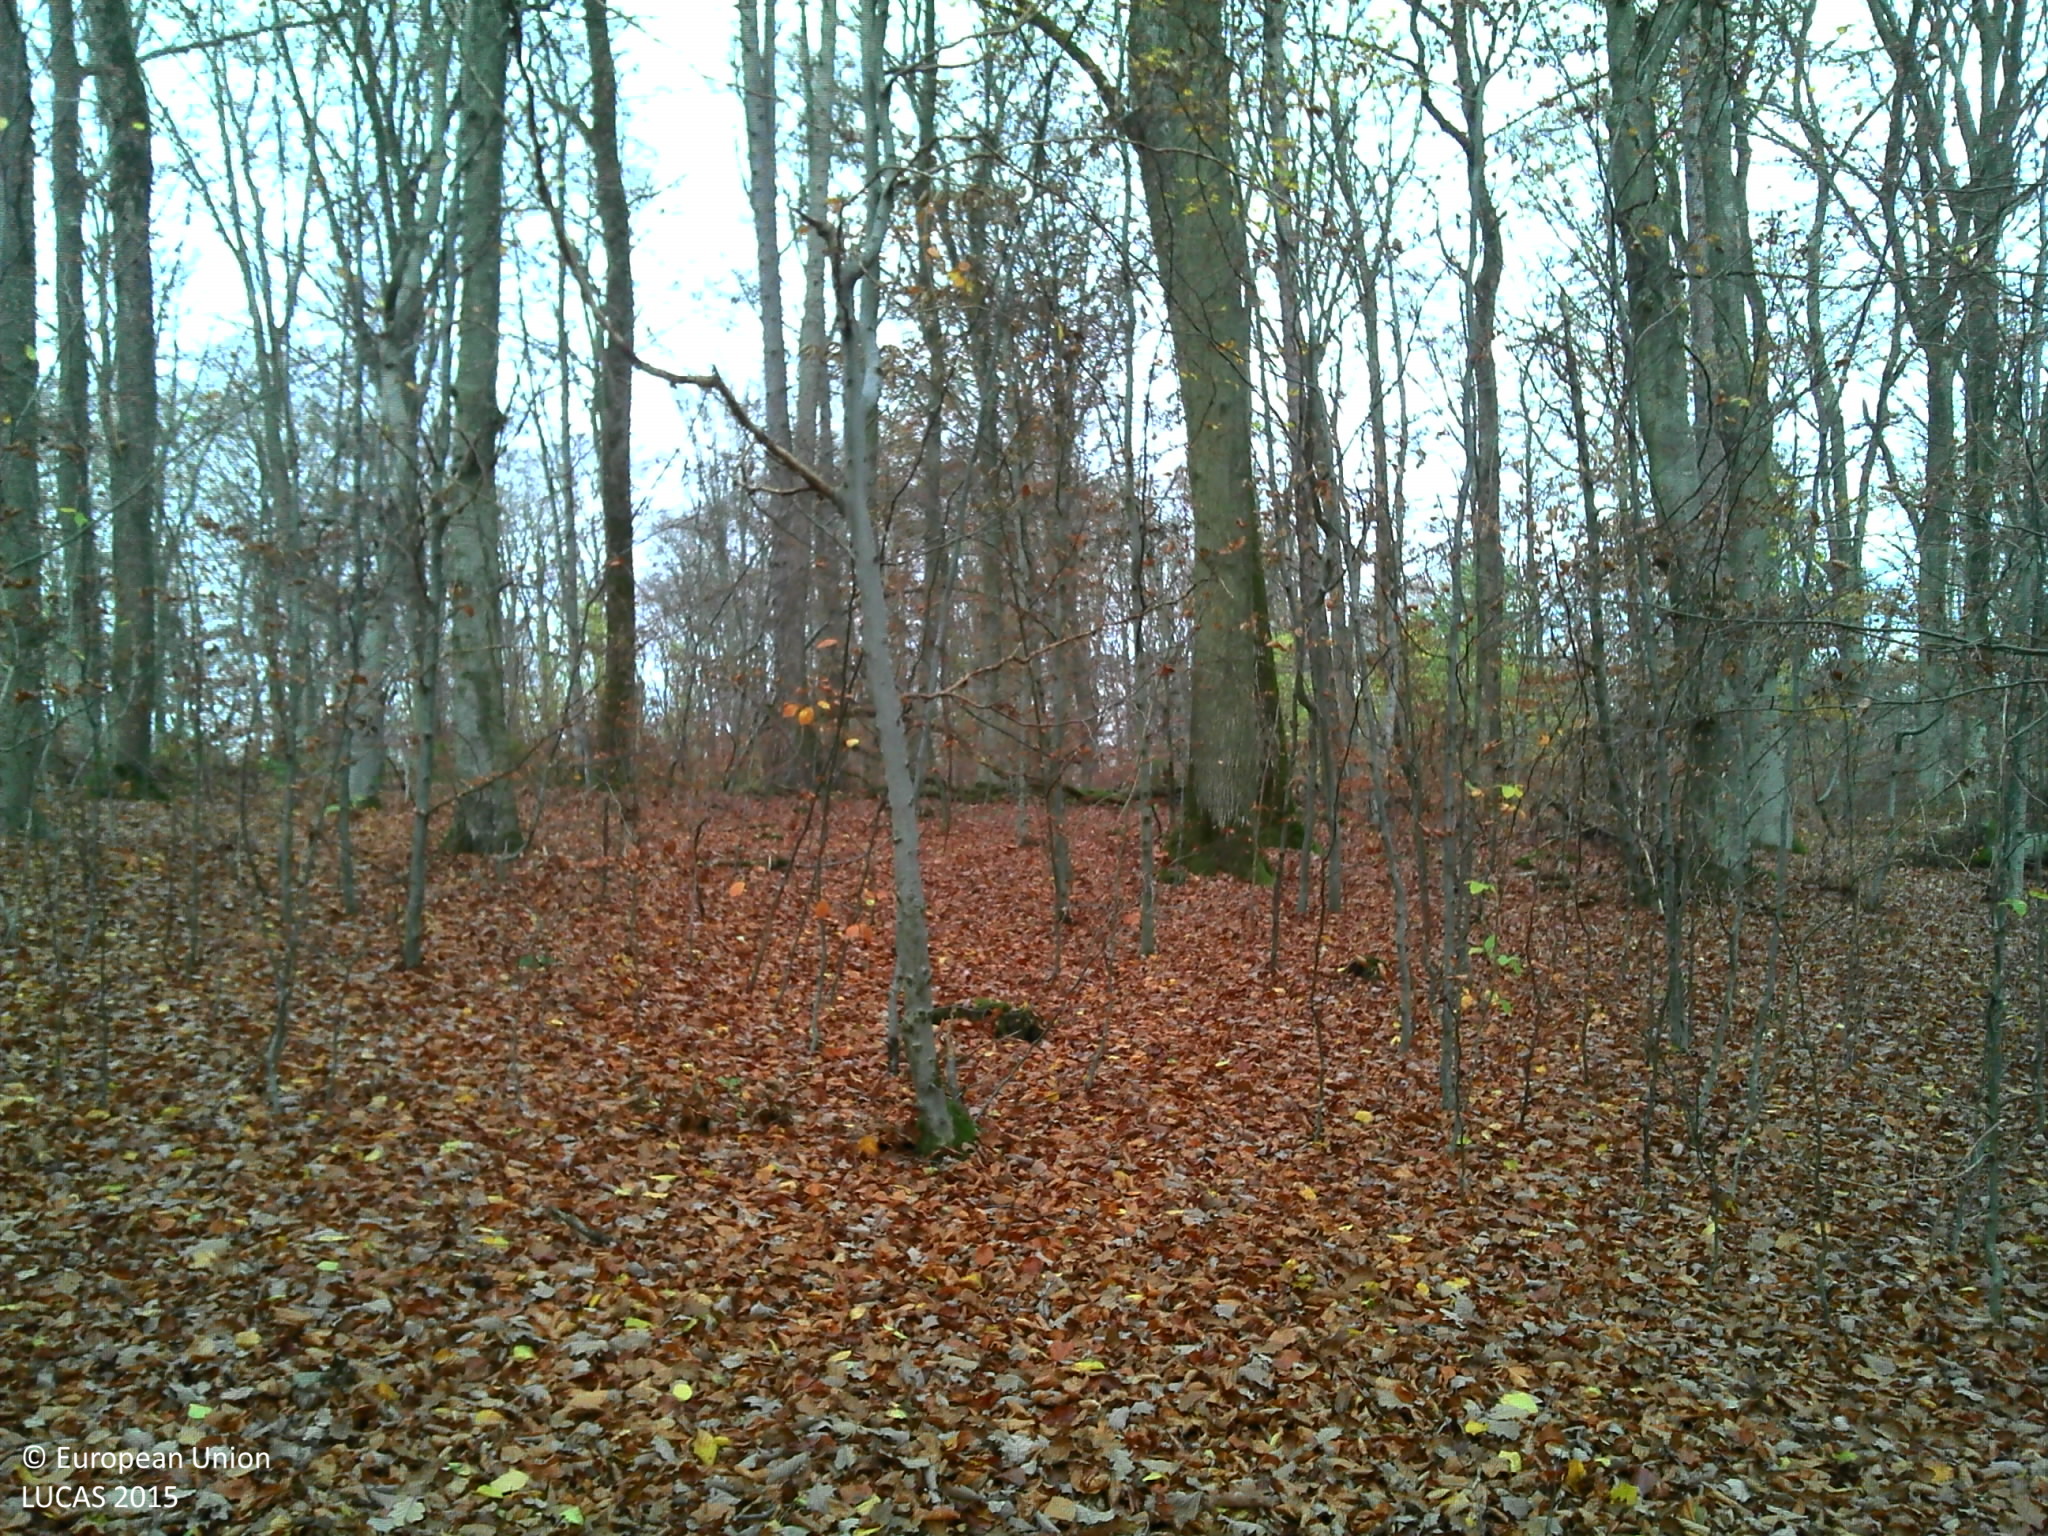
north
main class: Woodland
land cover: Broadleaved woodland
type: beech forest
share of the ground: > 75 %
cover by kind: broadleaved forest trees 100 %
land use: Forestry
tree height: > 5 m
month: November
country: LU
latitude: 49.6032
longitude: 6.3328
